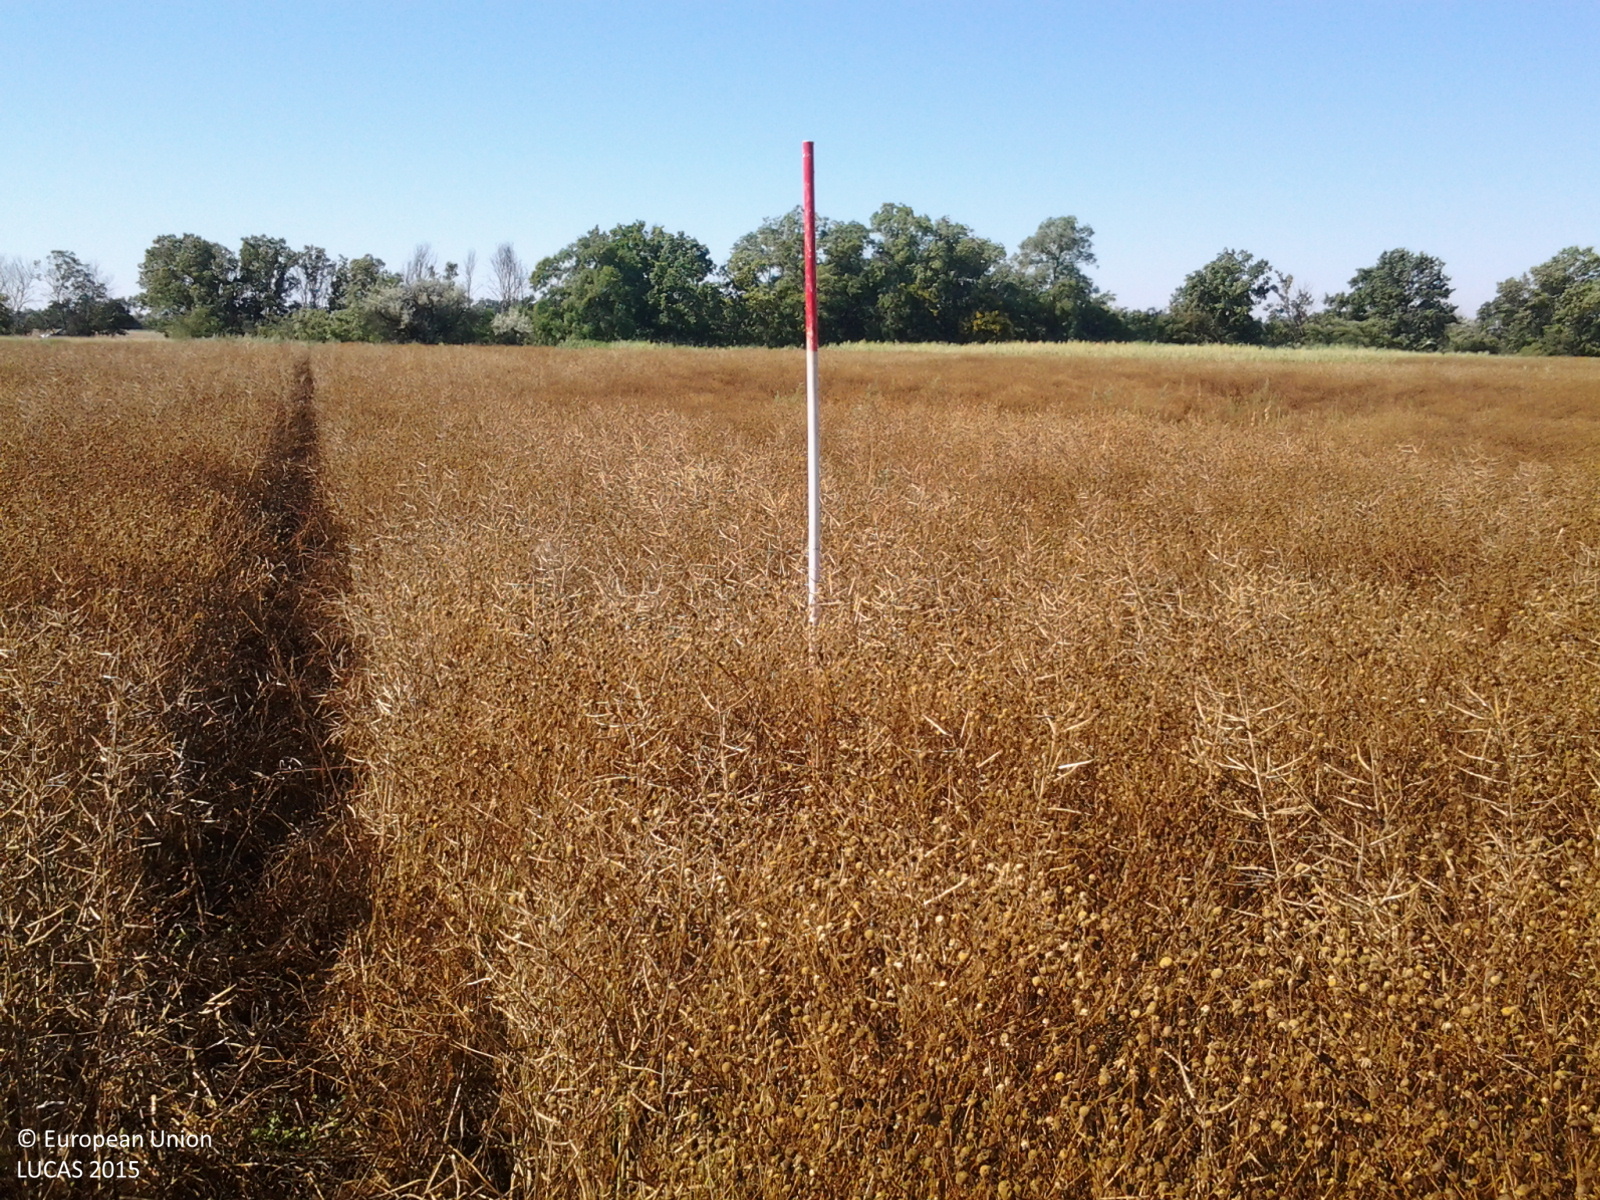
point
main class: Cropland
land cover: Rape and turnip rape
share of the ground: > 75 %
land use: Agriculture (excluding fallow land and kitchen gardens)
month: July
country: HU
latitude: 47.0168
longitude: 20.4606
